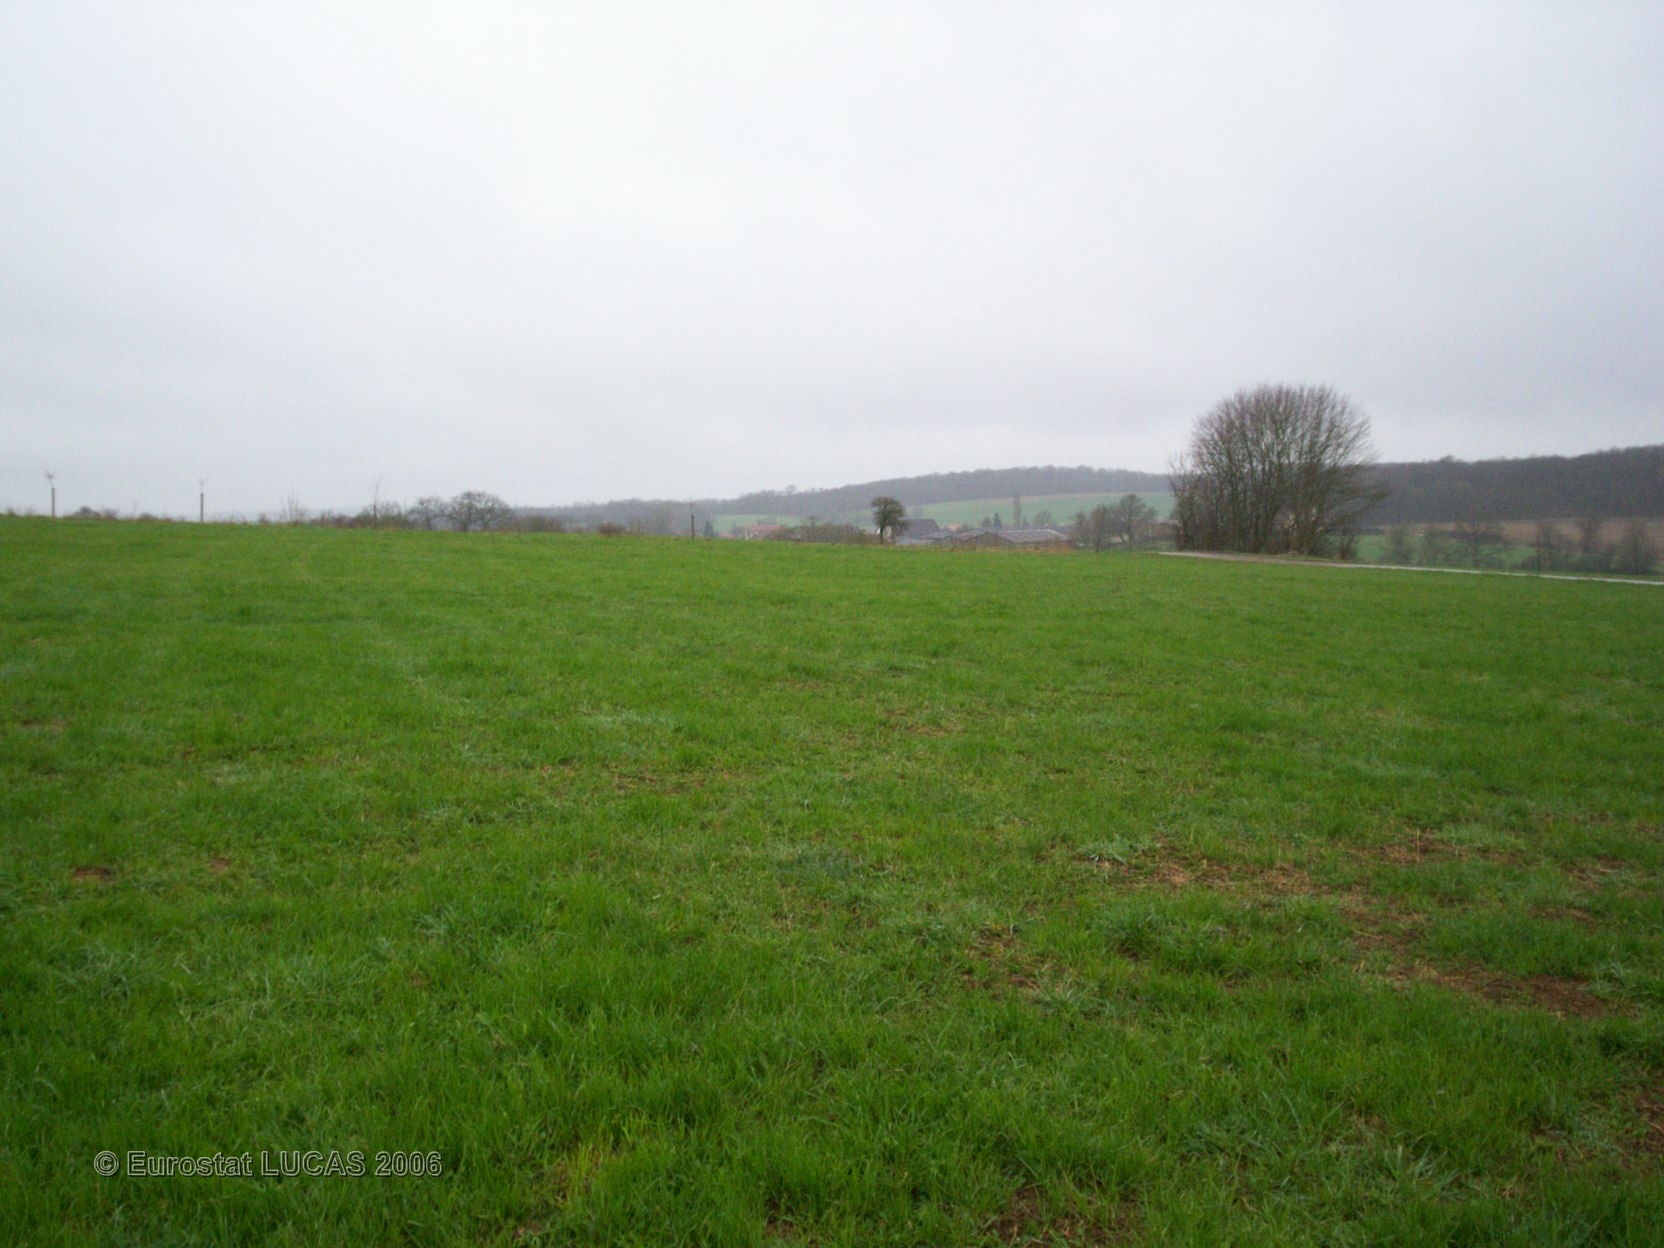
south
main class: Grassland
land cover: Grassland without tree/shrub cover
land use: Agriculture (excluding fallow land and kitchen gardens)
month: April
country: FR
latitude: 48.5917
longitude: 6.8144
